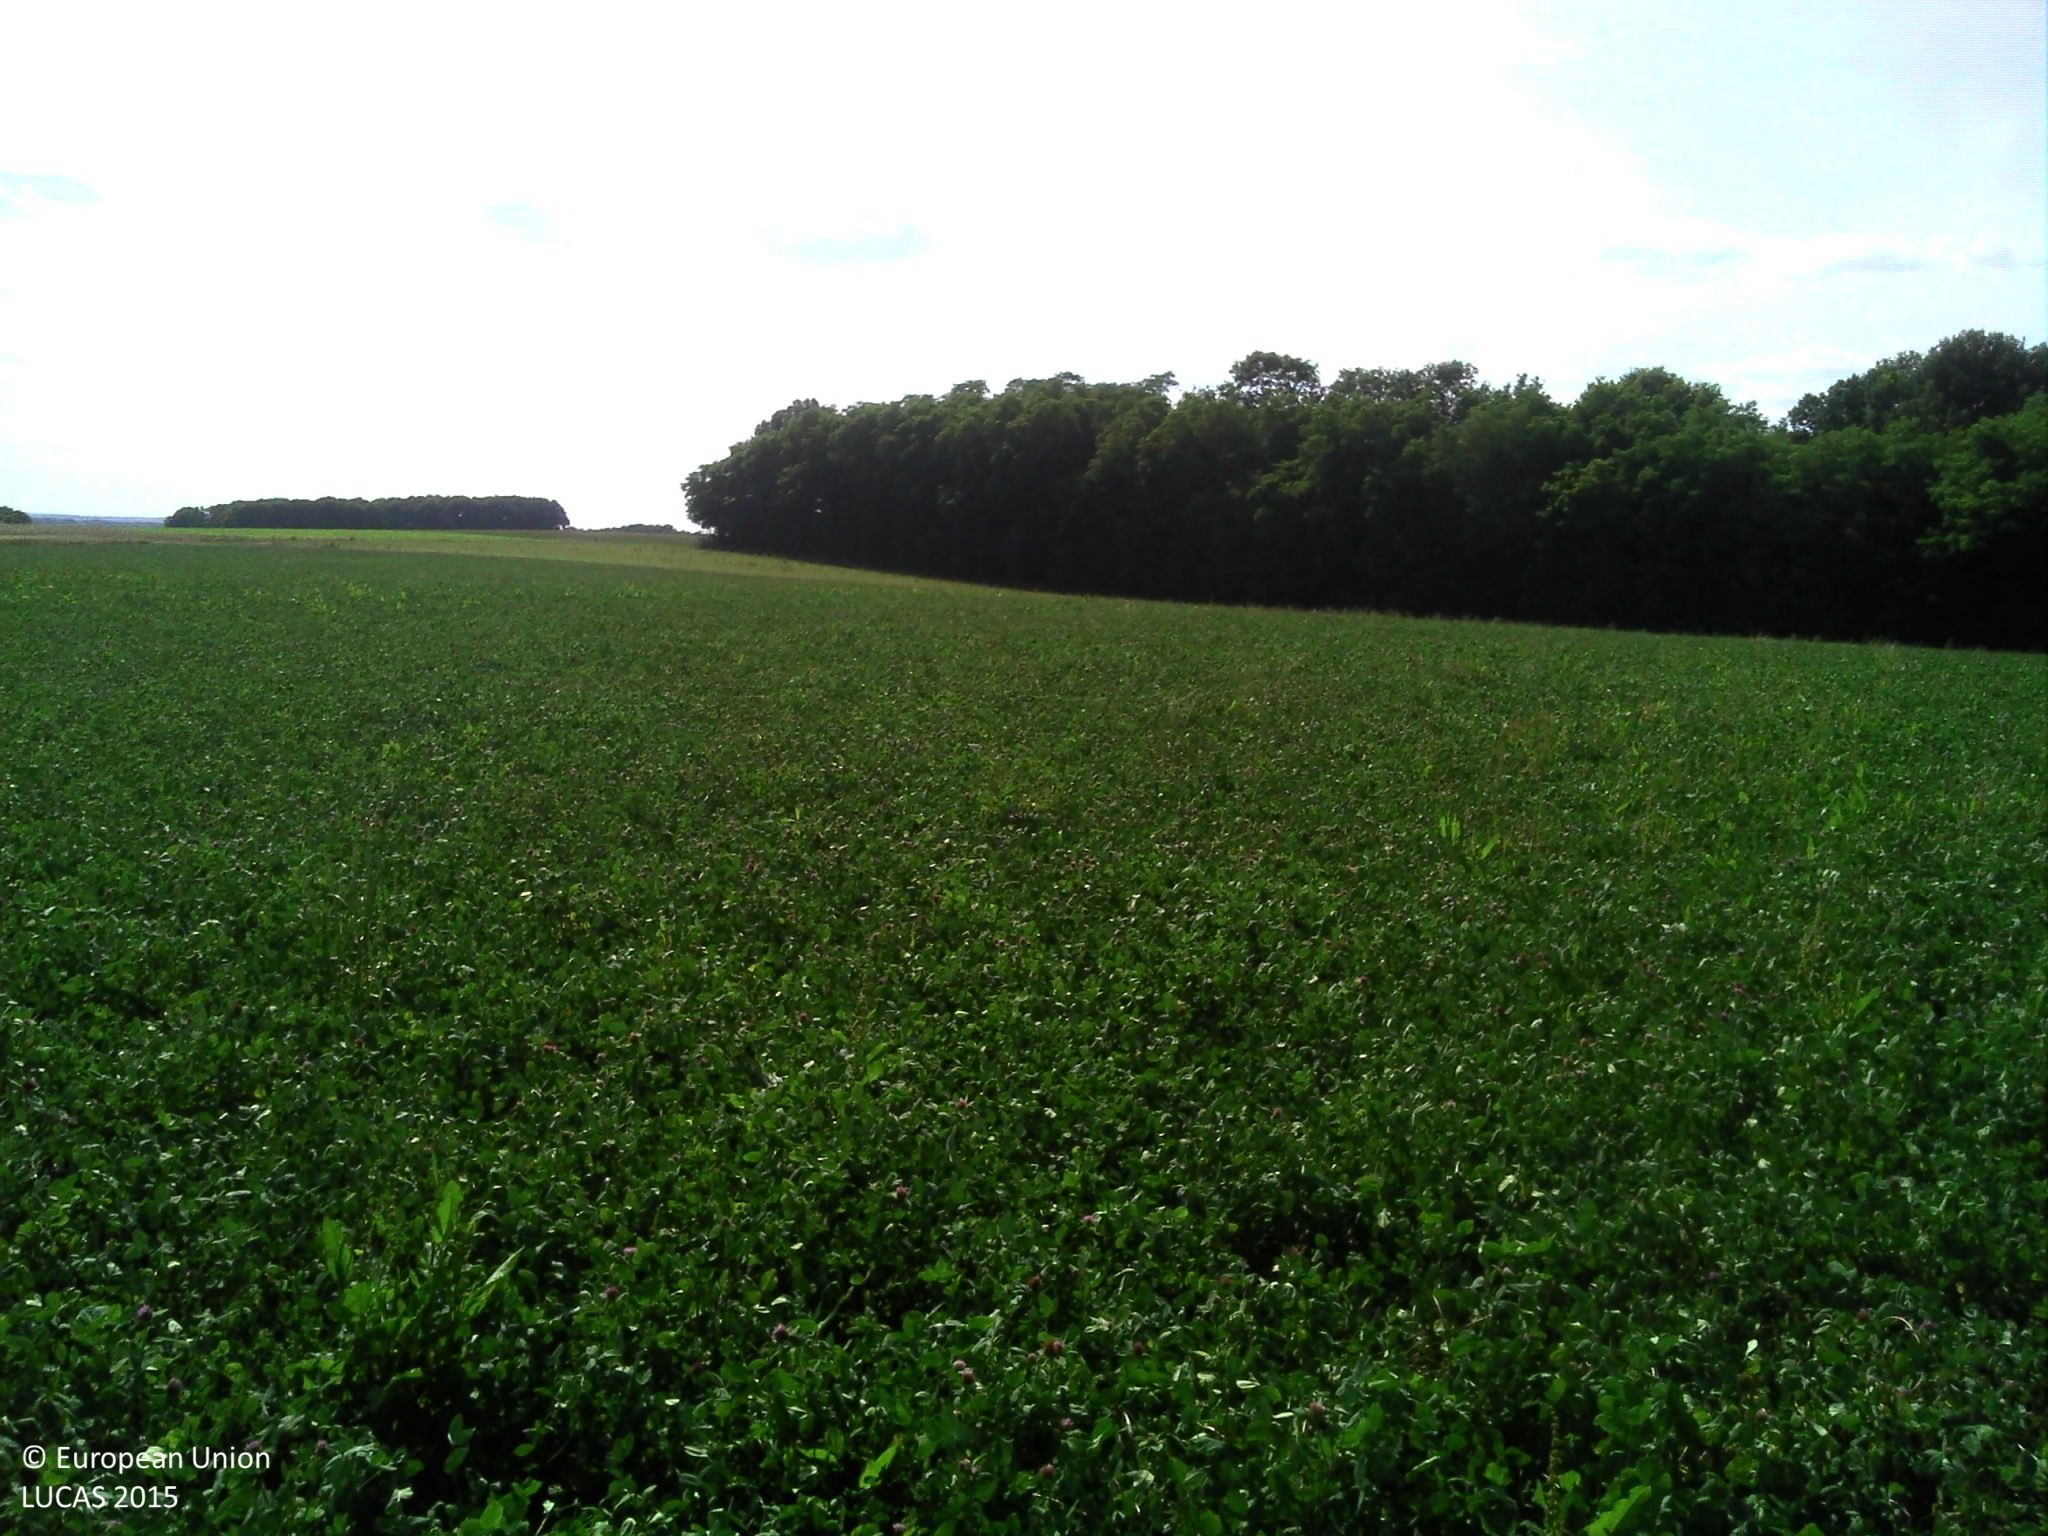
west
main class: Cropland
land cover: Clovers
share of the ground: > 75 %
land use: Agriculture (excluding fallow land and kitchen gardens)
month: June
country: FR
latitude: 48.0996
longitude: 3.4280
